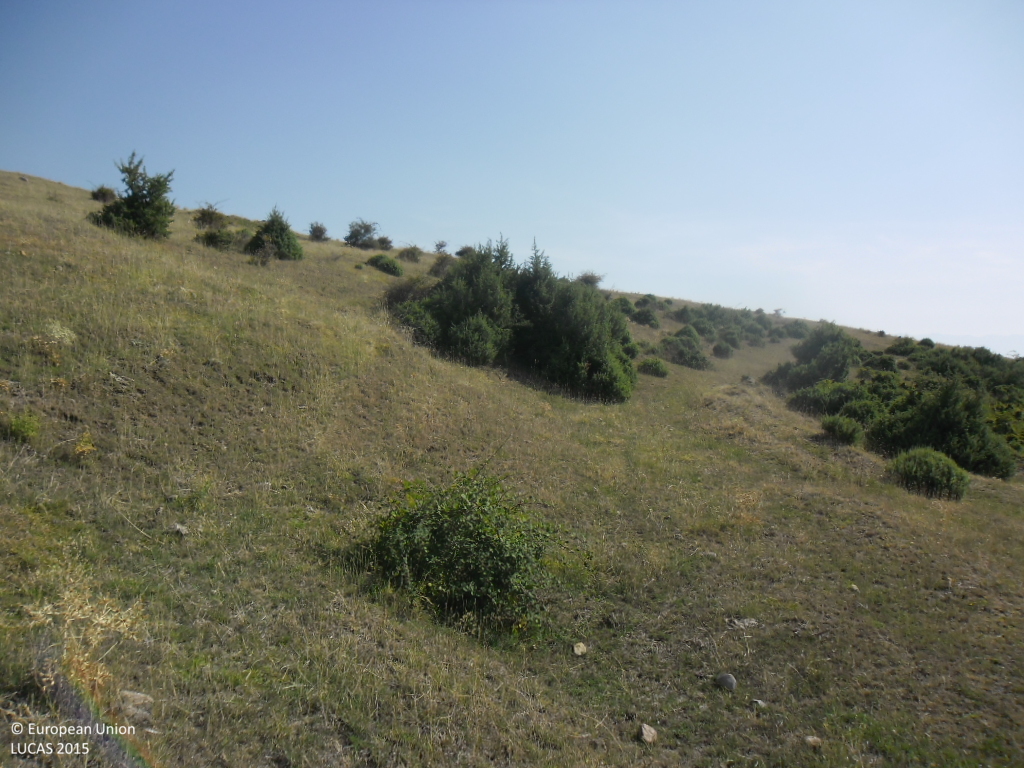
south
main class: Grassland
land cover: Grassland without tree/shrub cover
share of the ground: > 75 %
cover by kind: herbaceous plants 100 %
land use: Agriculture (excluding fallow land and kitchen gardens)
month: September
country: BG
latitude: 41.5927
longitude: 23.2784
